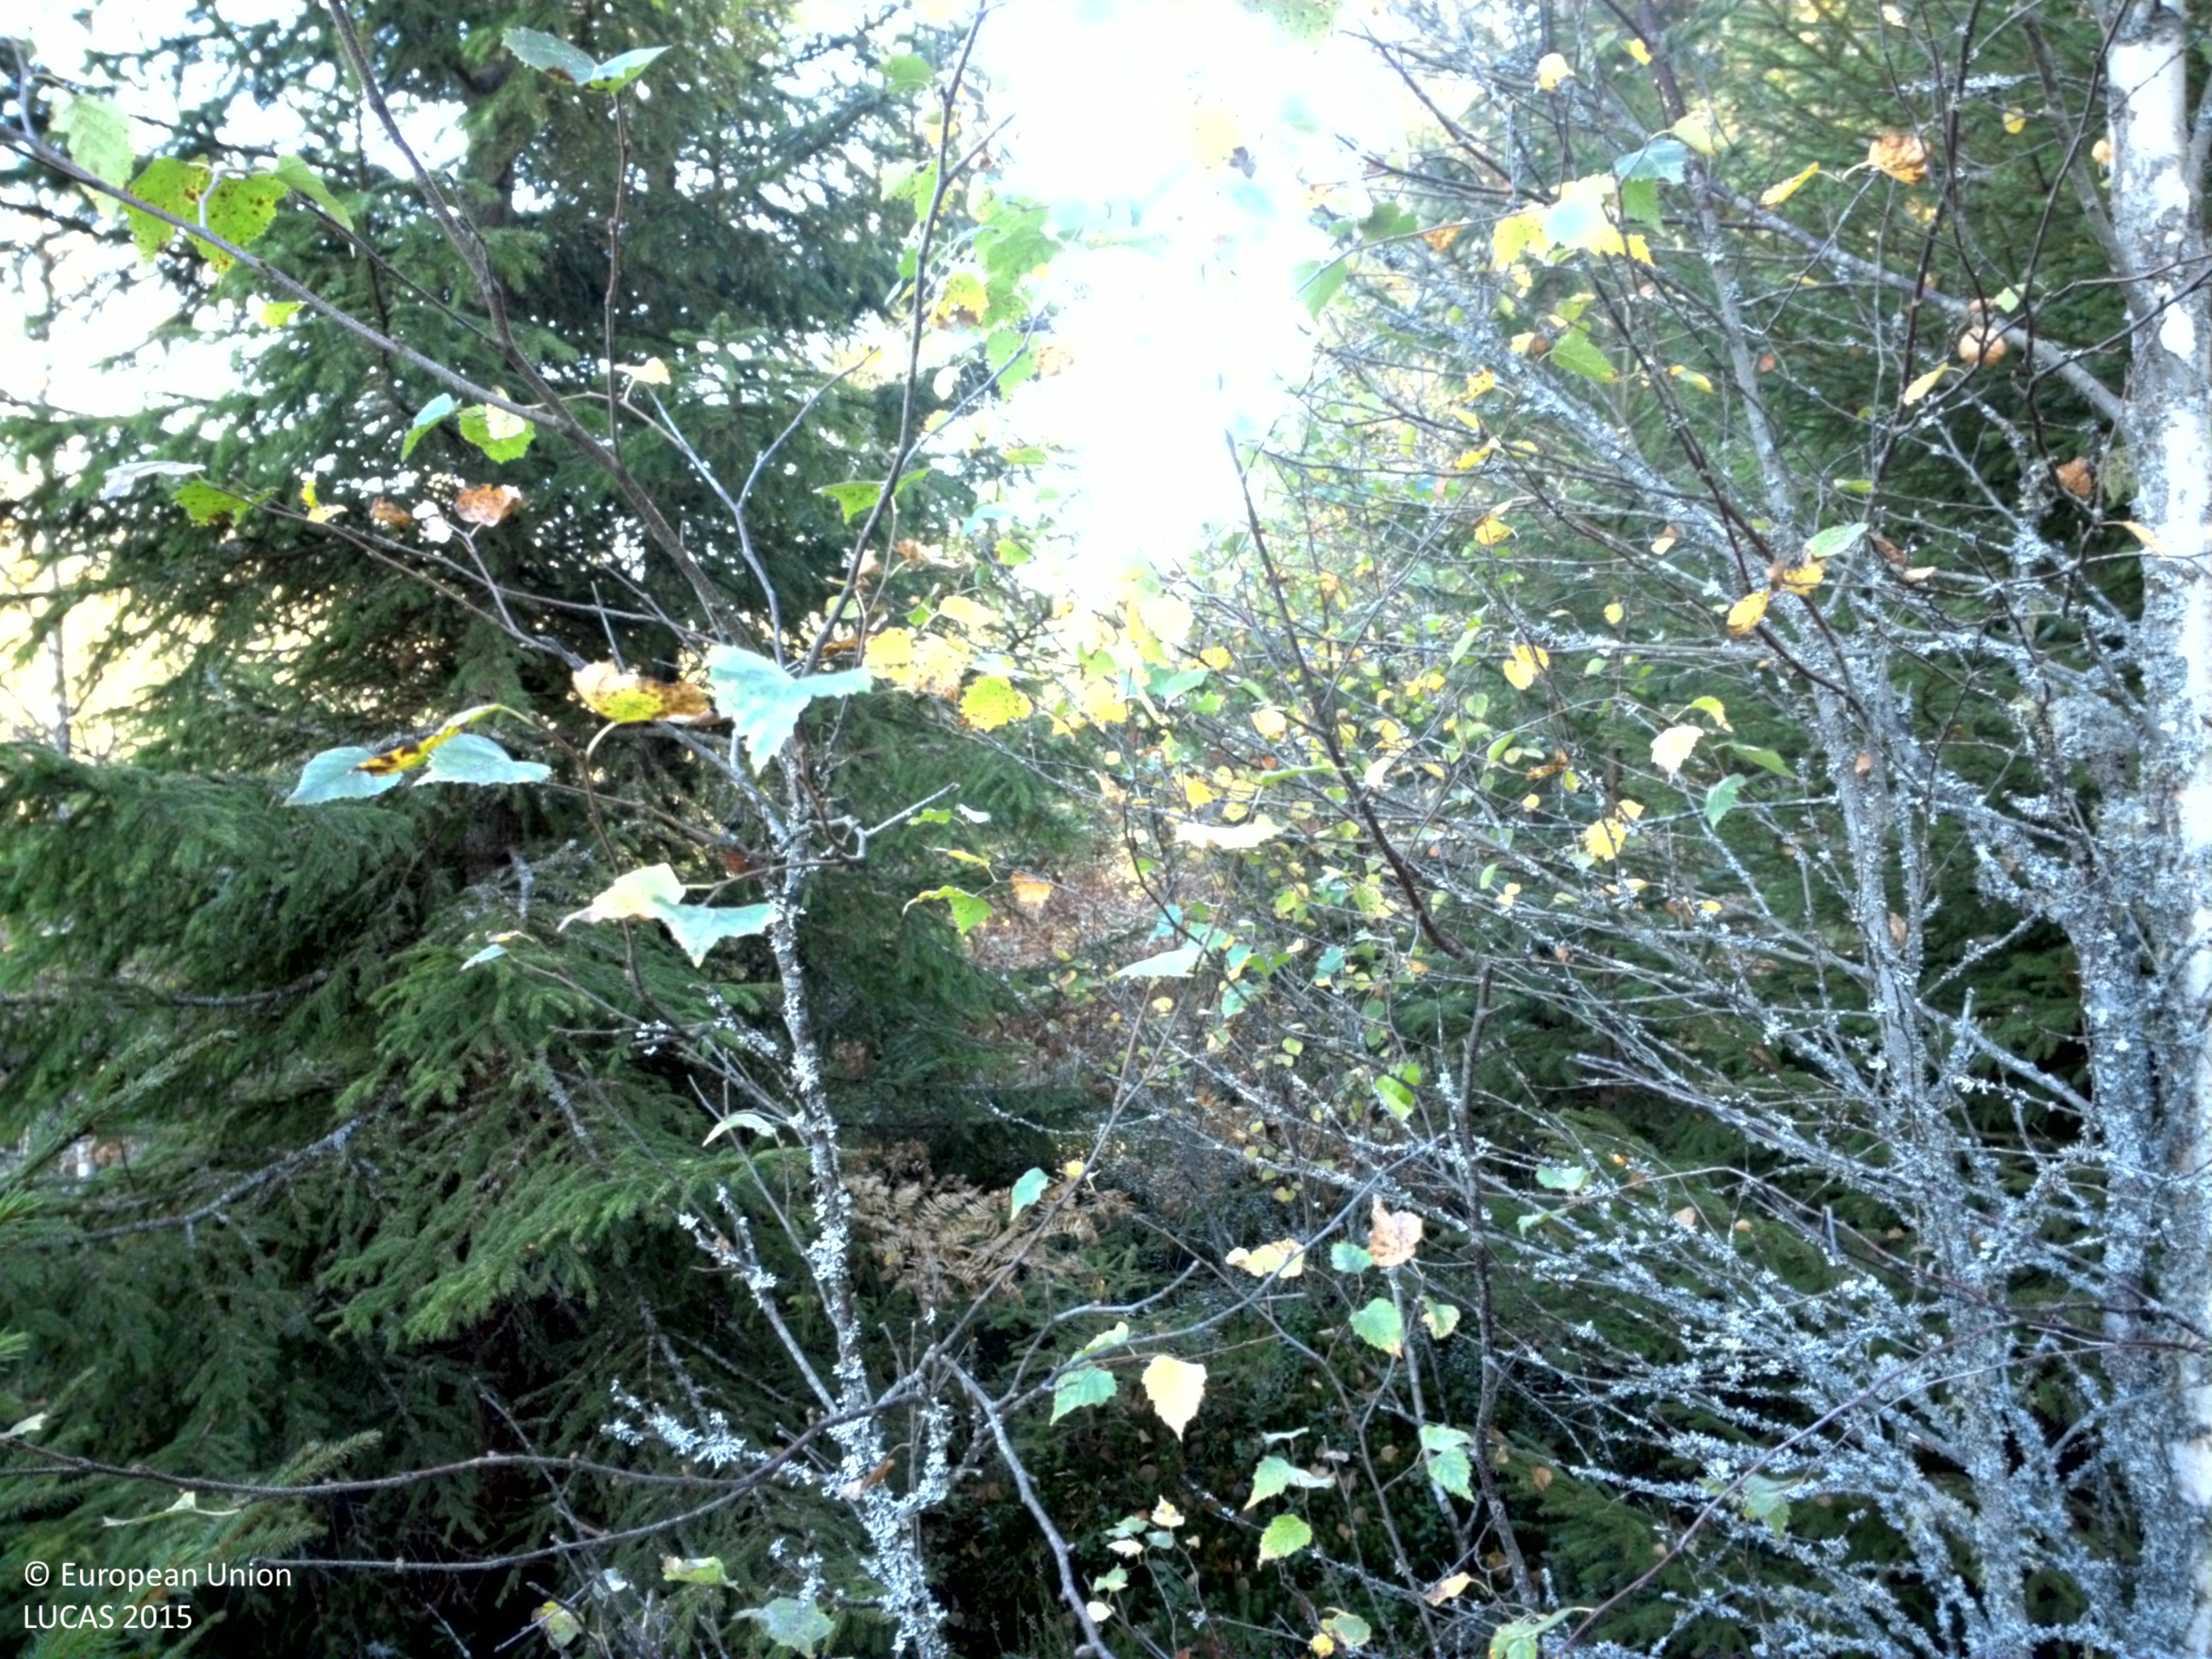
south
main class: Woodland
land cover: Spruce dominated mixed woodland
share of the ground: 10 - 25 %
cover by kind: shrubs 30 %, herbaceous plants 30 %, coniferous forest trees 15 %, lichens and mosses 15 %, broadleaved forest trees 10 %
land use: Forestry
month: September
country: SE
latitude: 59.1309
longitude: 14.0635
